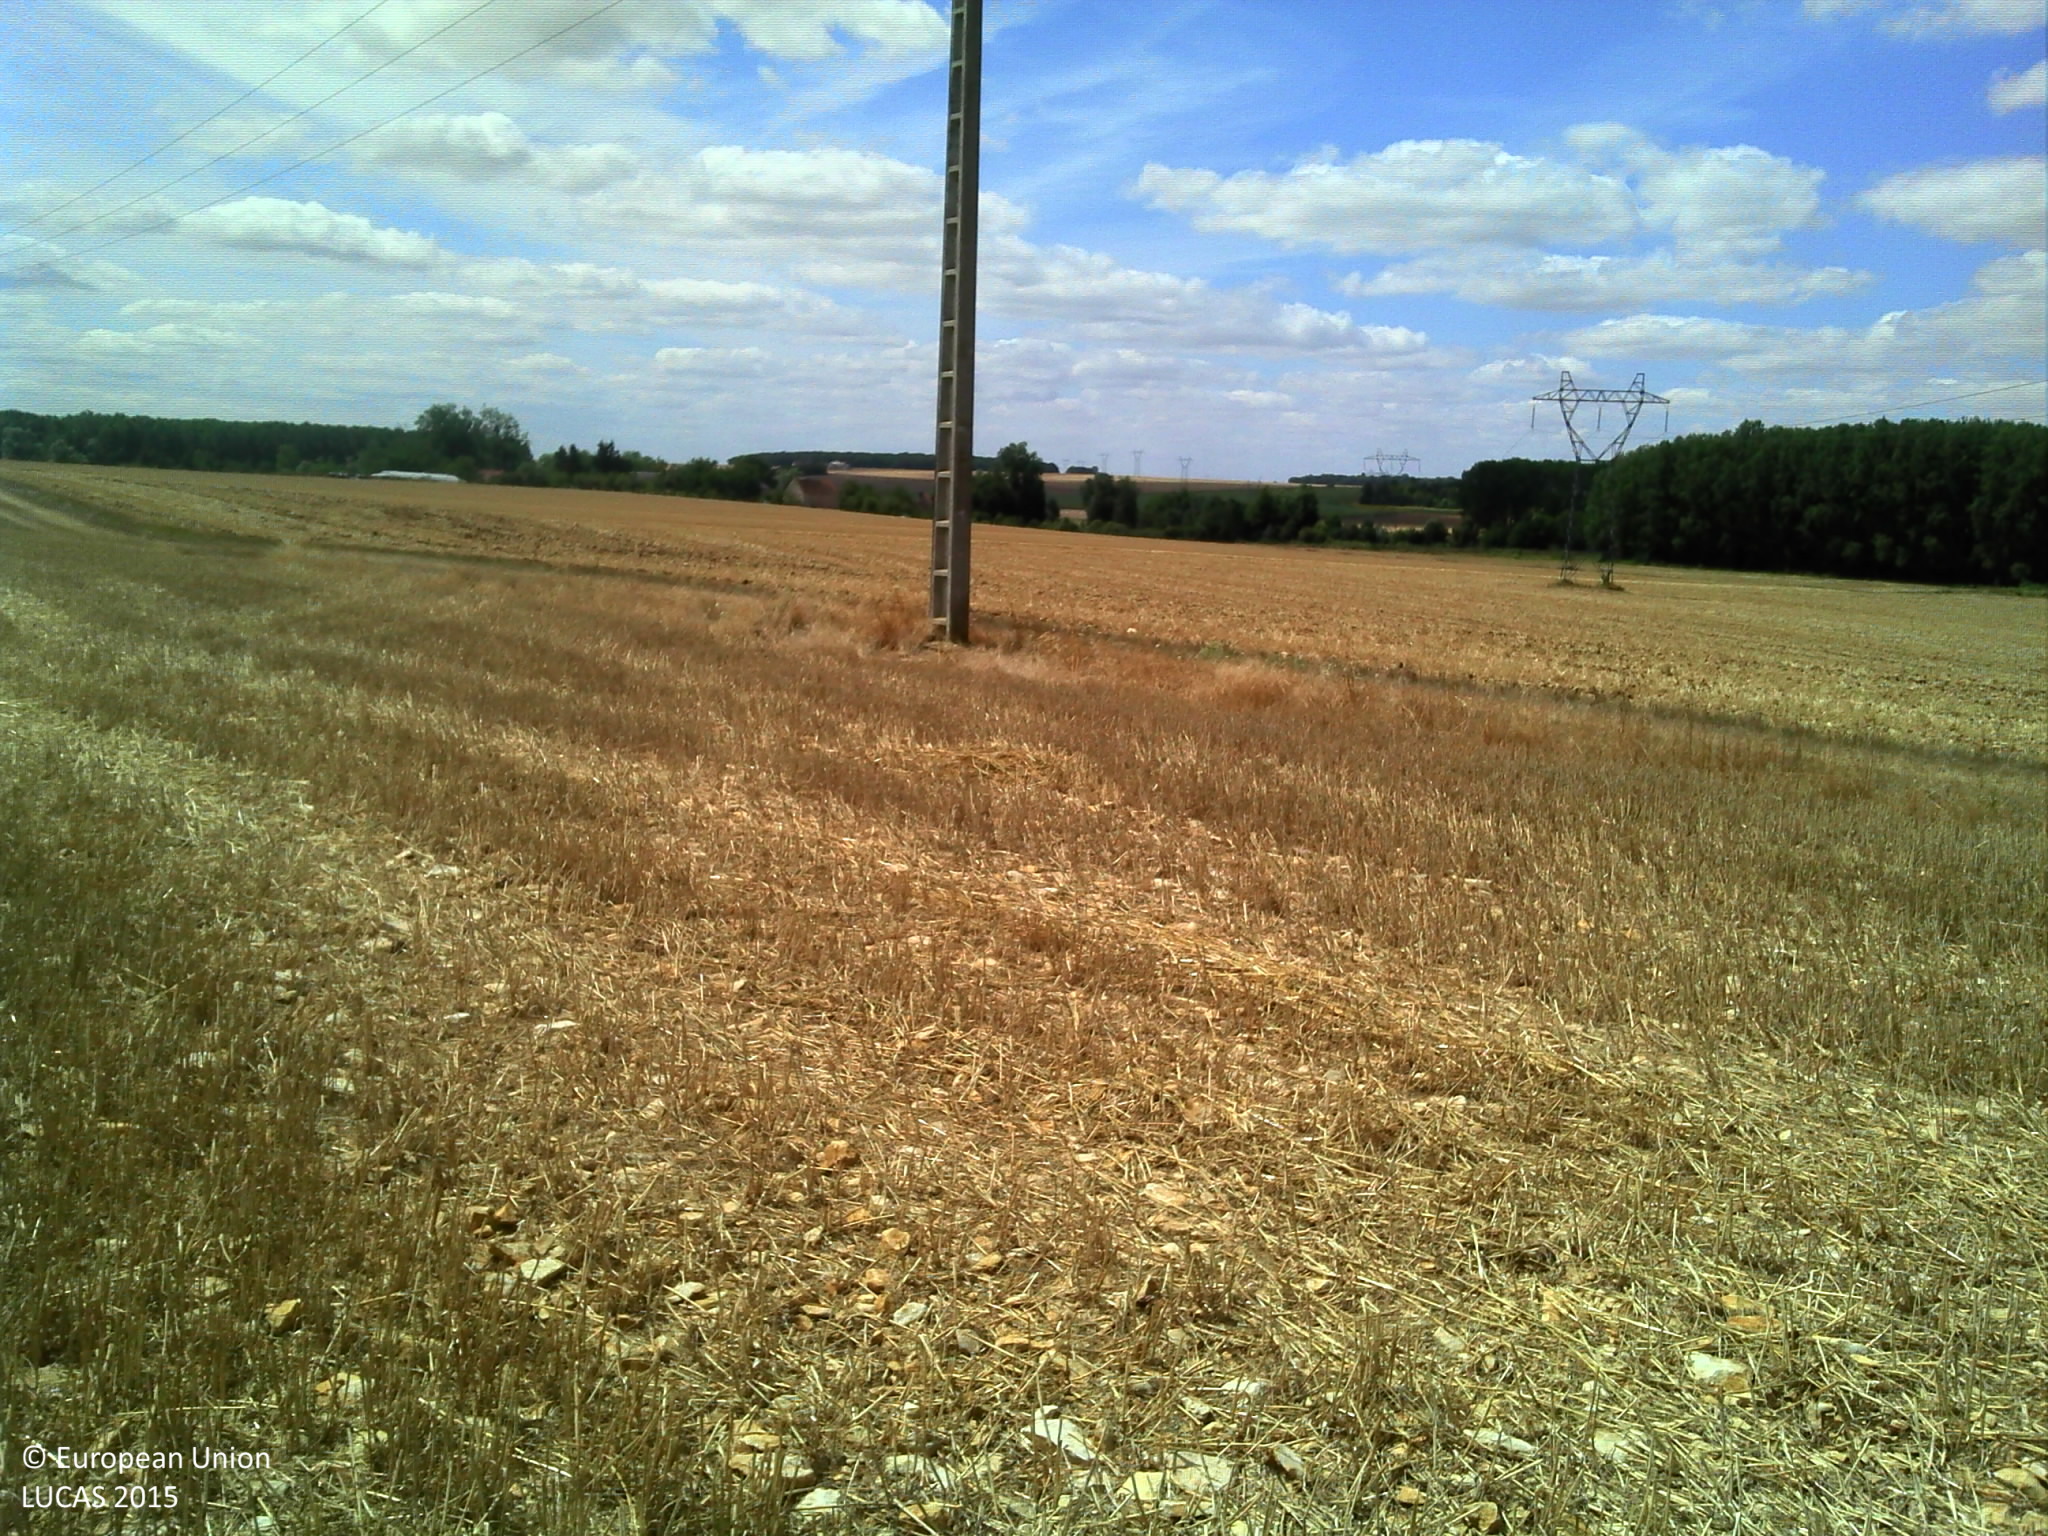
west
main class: Cropland
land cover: Common wheat
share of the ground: > 75 %
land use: Agriculture (excluding fallow land and kitchen gardens)
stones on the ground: 10 - 25 %
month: July
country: FR
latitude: 46.9468
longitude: 2.1220
